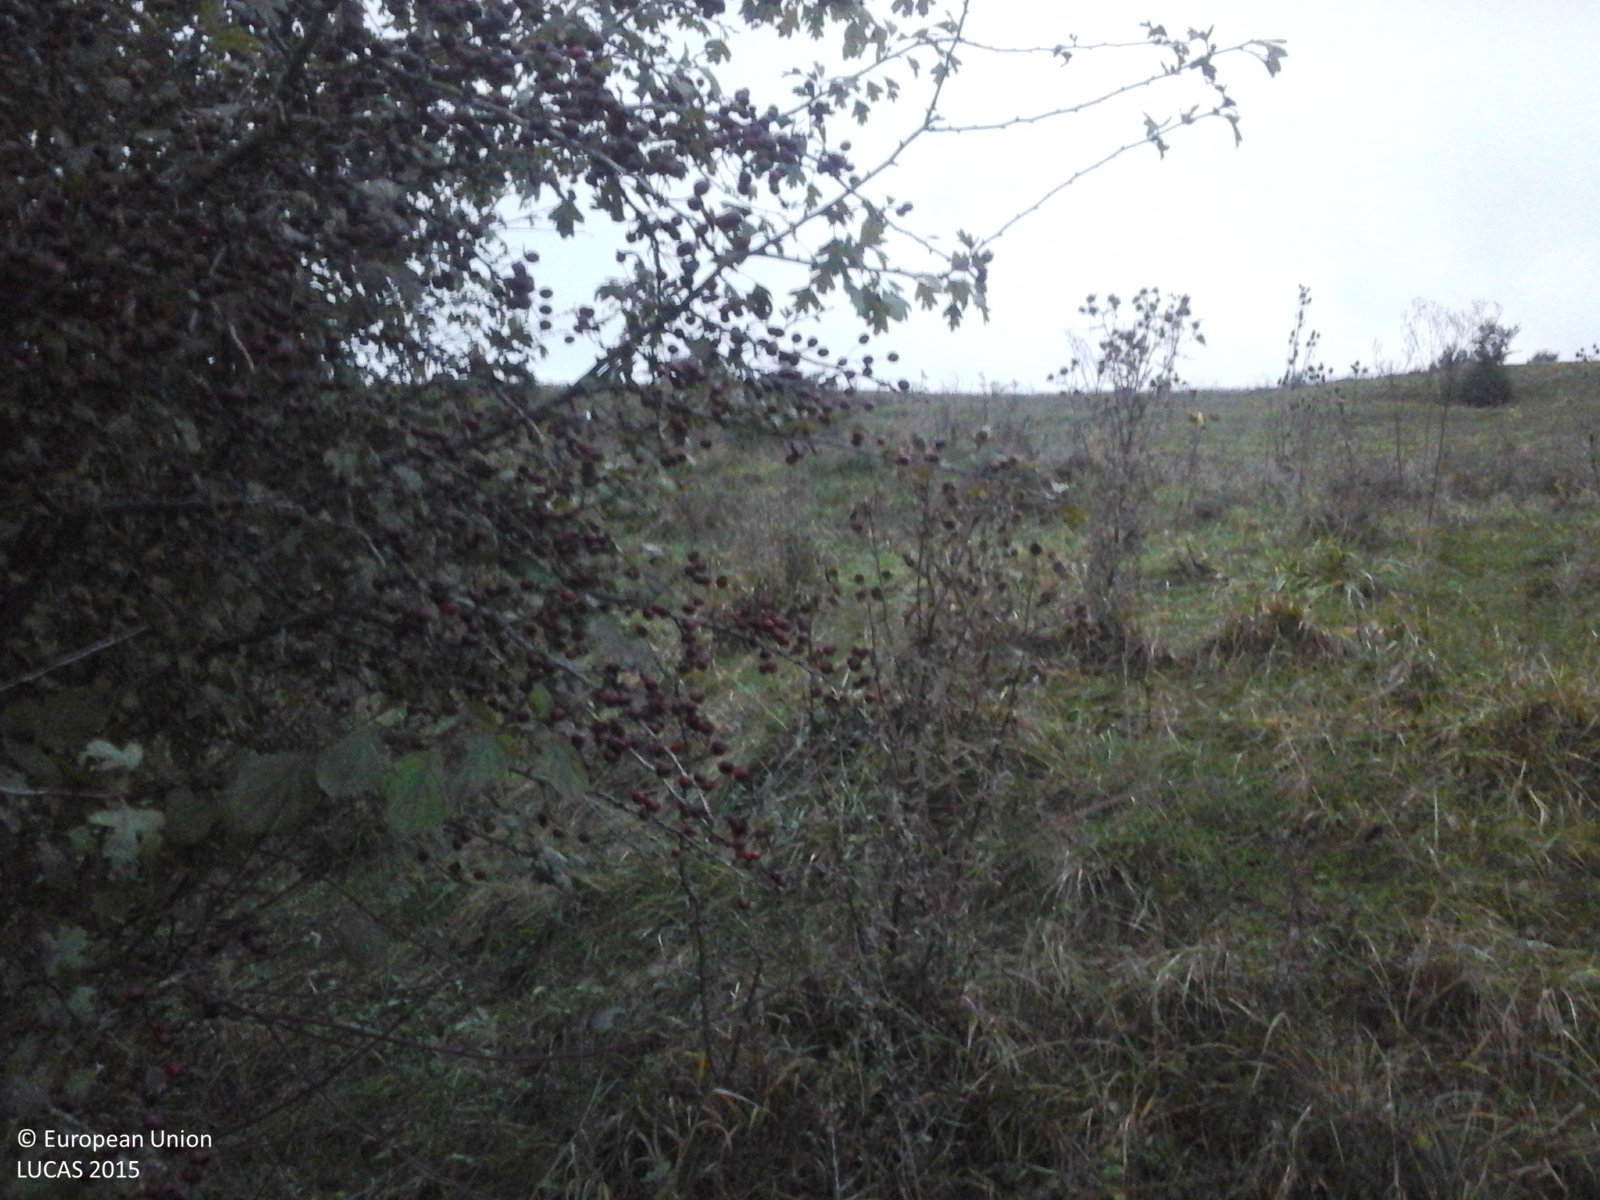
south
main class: Grassland
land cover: Grassland with sparse tree/shrub cover
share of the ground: > 75 %
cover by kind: herbaceous plants 85 %, shrubs 10 %, broadleaved forest trees 5 %
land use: Agriculture (excluding fallow land and kitchen gardens)
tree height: > 5 m
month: October
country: RO
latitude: 45.9175
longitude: 24.1422
